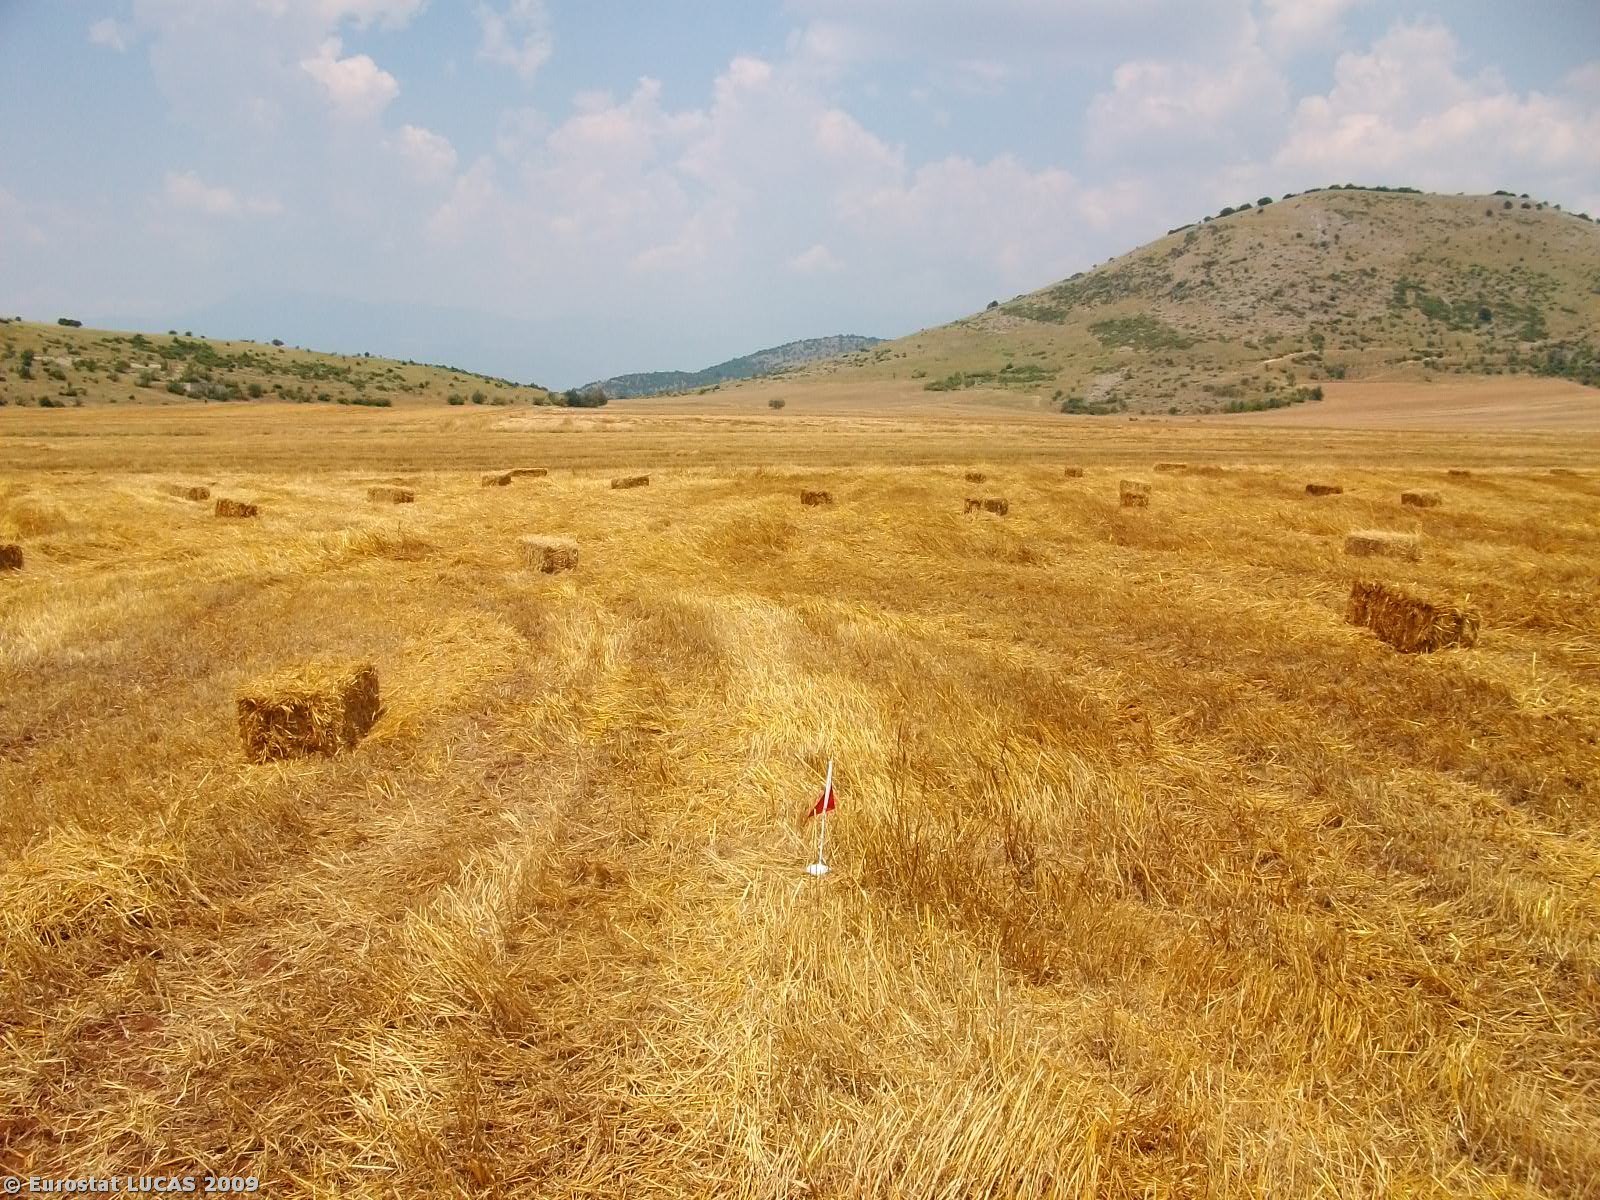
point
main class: Cropland
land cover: Durum wheat
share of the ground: < 10 %
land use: Agriculture (excluding fallow land and kitchen gardens)
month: July
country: GR
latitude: 40.6978
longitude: 21.8430
